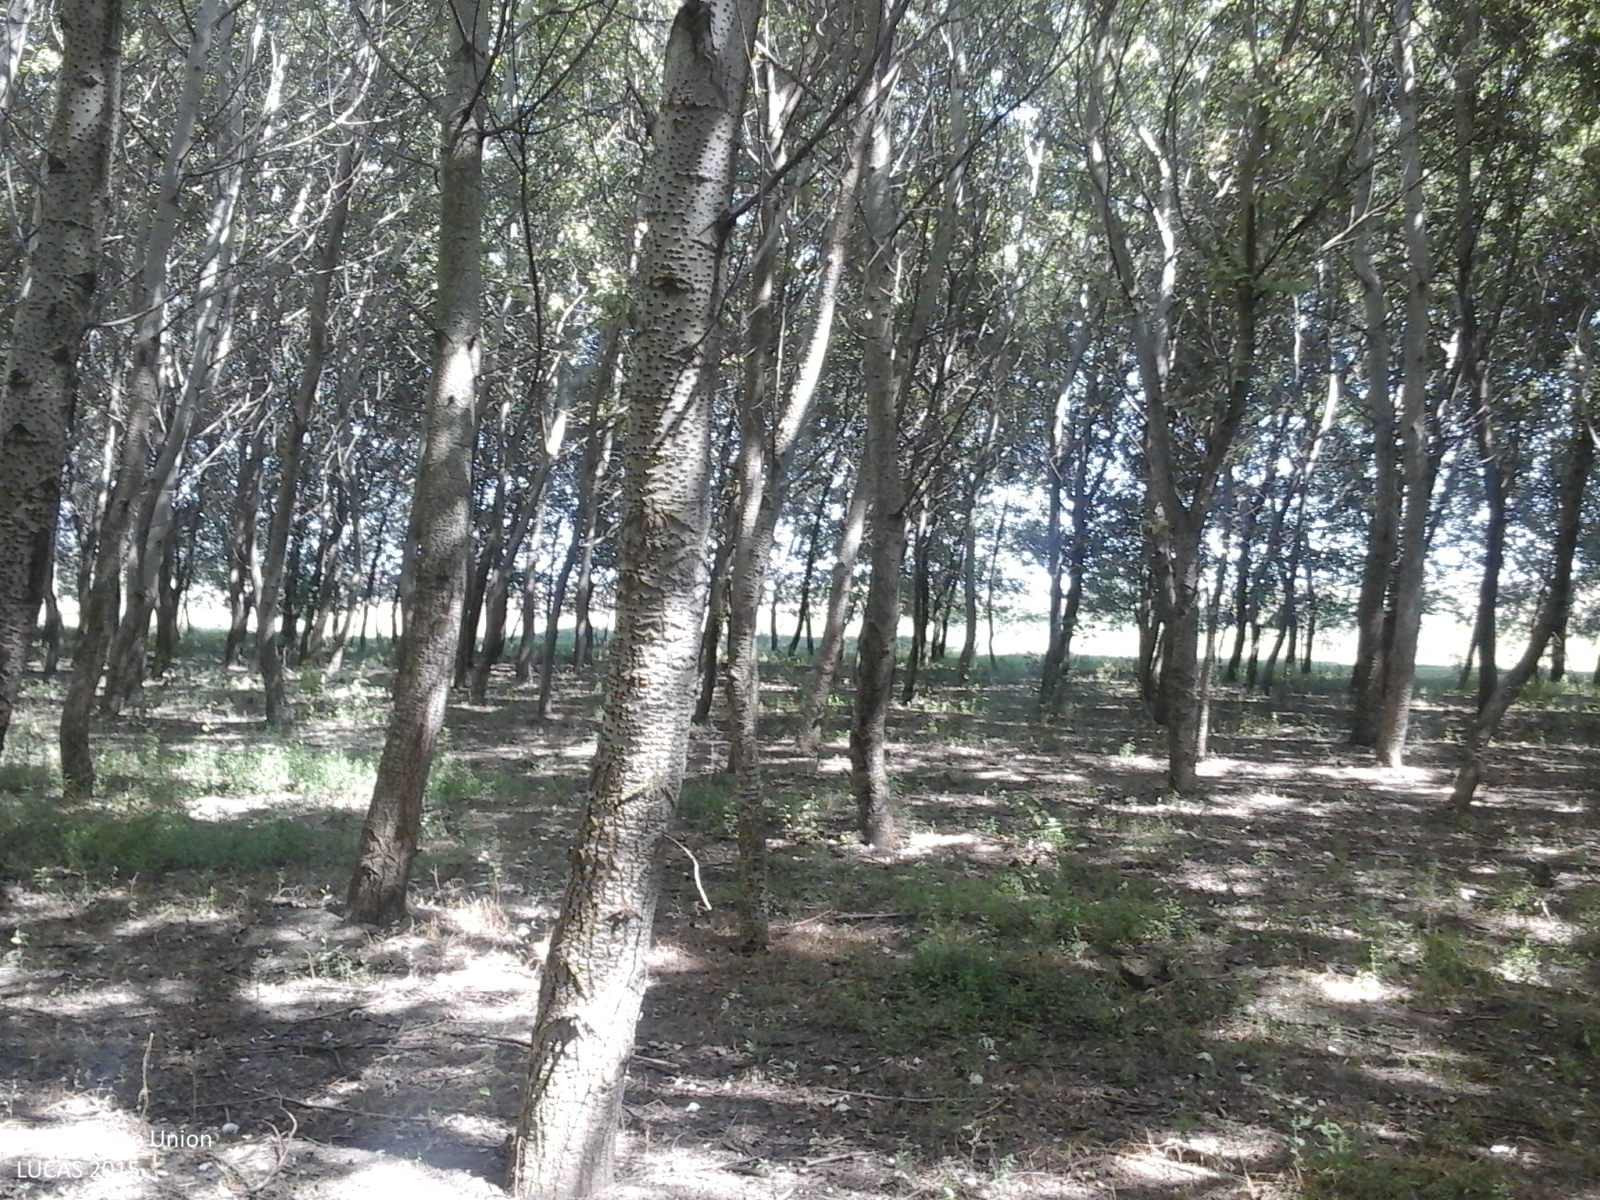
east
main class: Woodland
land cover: Broadleaved woodland
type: acidophilous oak and oak-birch forest
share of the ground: > 75 %
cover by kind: broadleaved forest trees 100 %
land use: Forestry
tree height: > 5 m
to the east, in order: Broadleaved woodland; Spontaneously vegetated surfaces; Ditches and canals; Spontaneously vegetated surfaces; Other bare soil
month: August
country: RO
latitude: 44.5549
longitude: 28.1787
